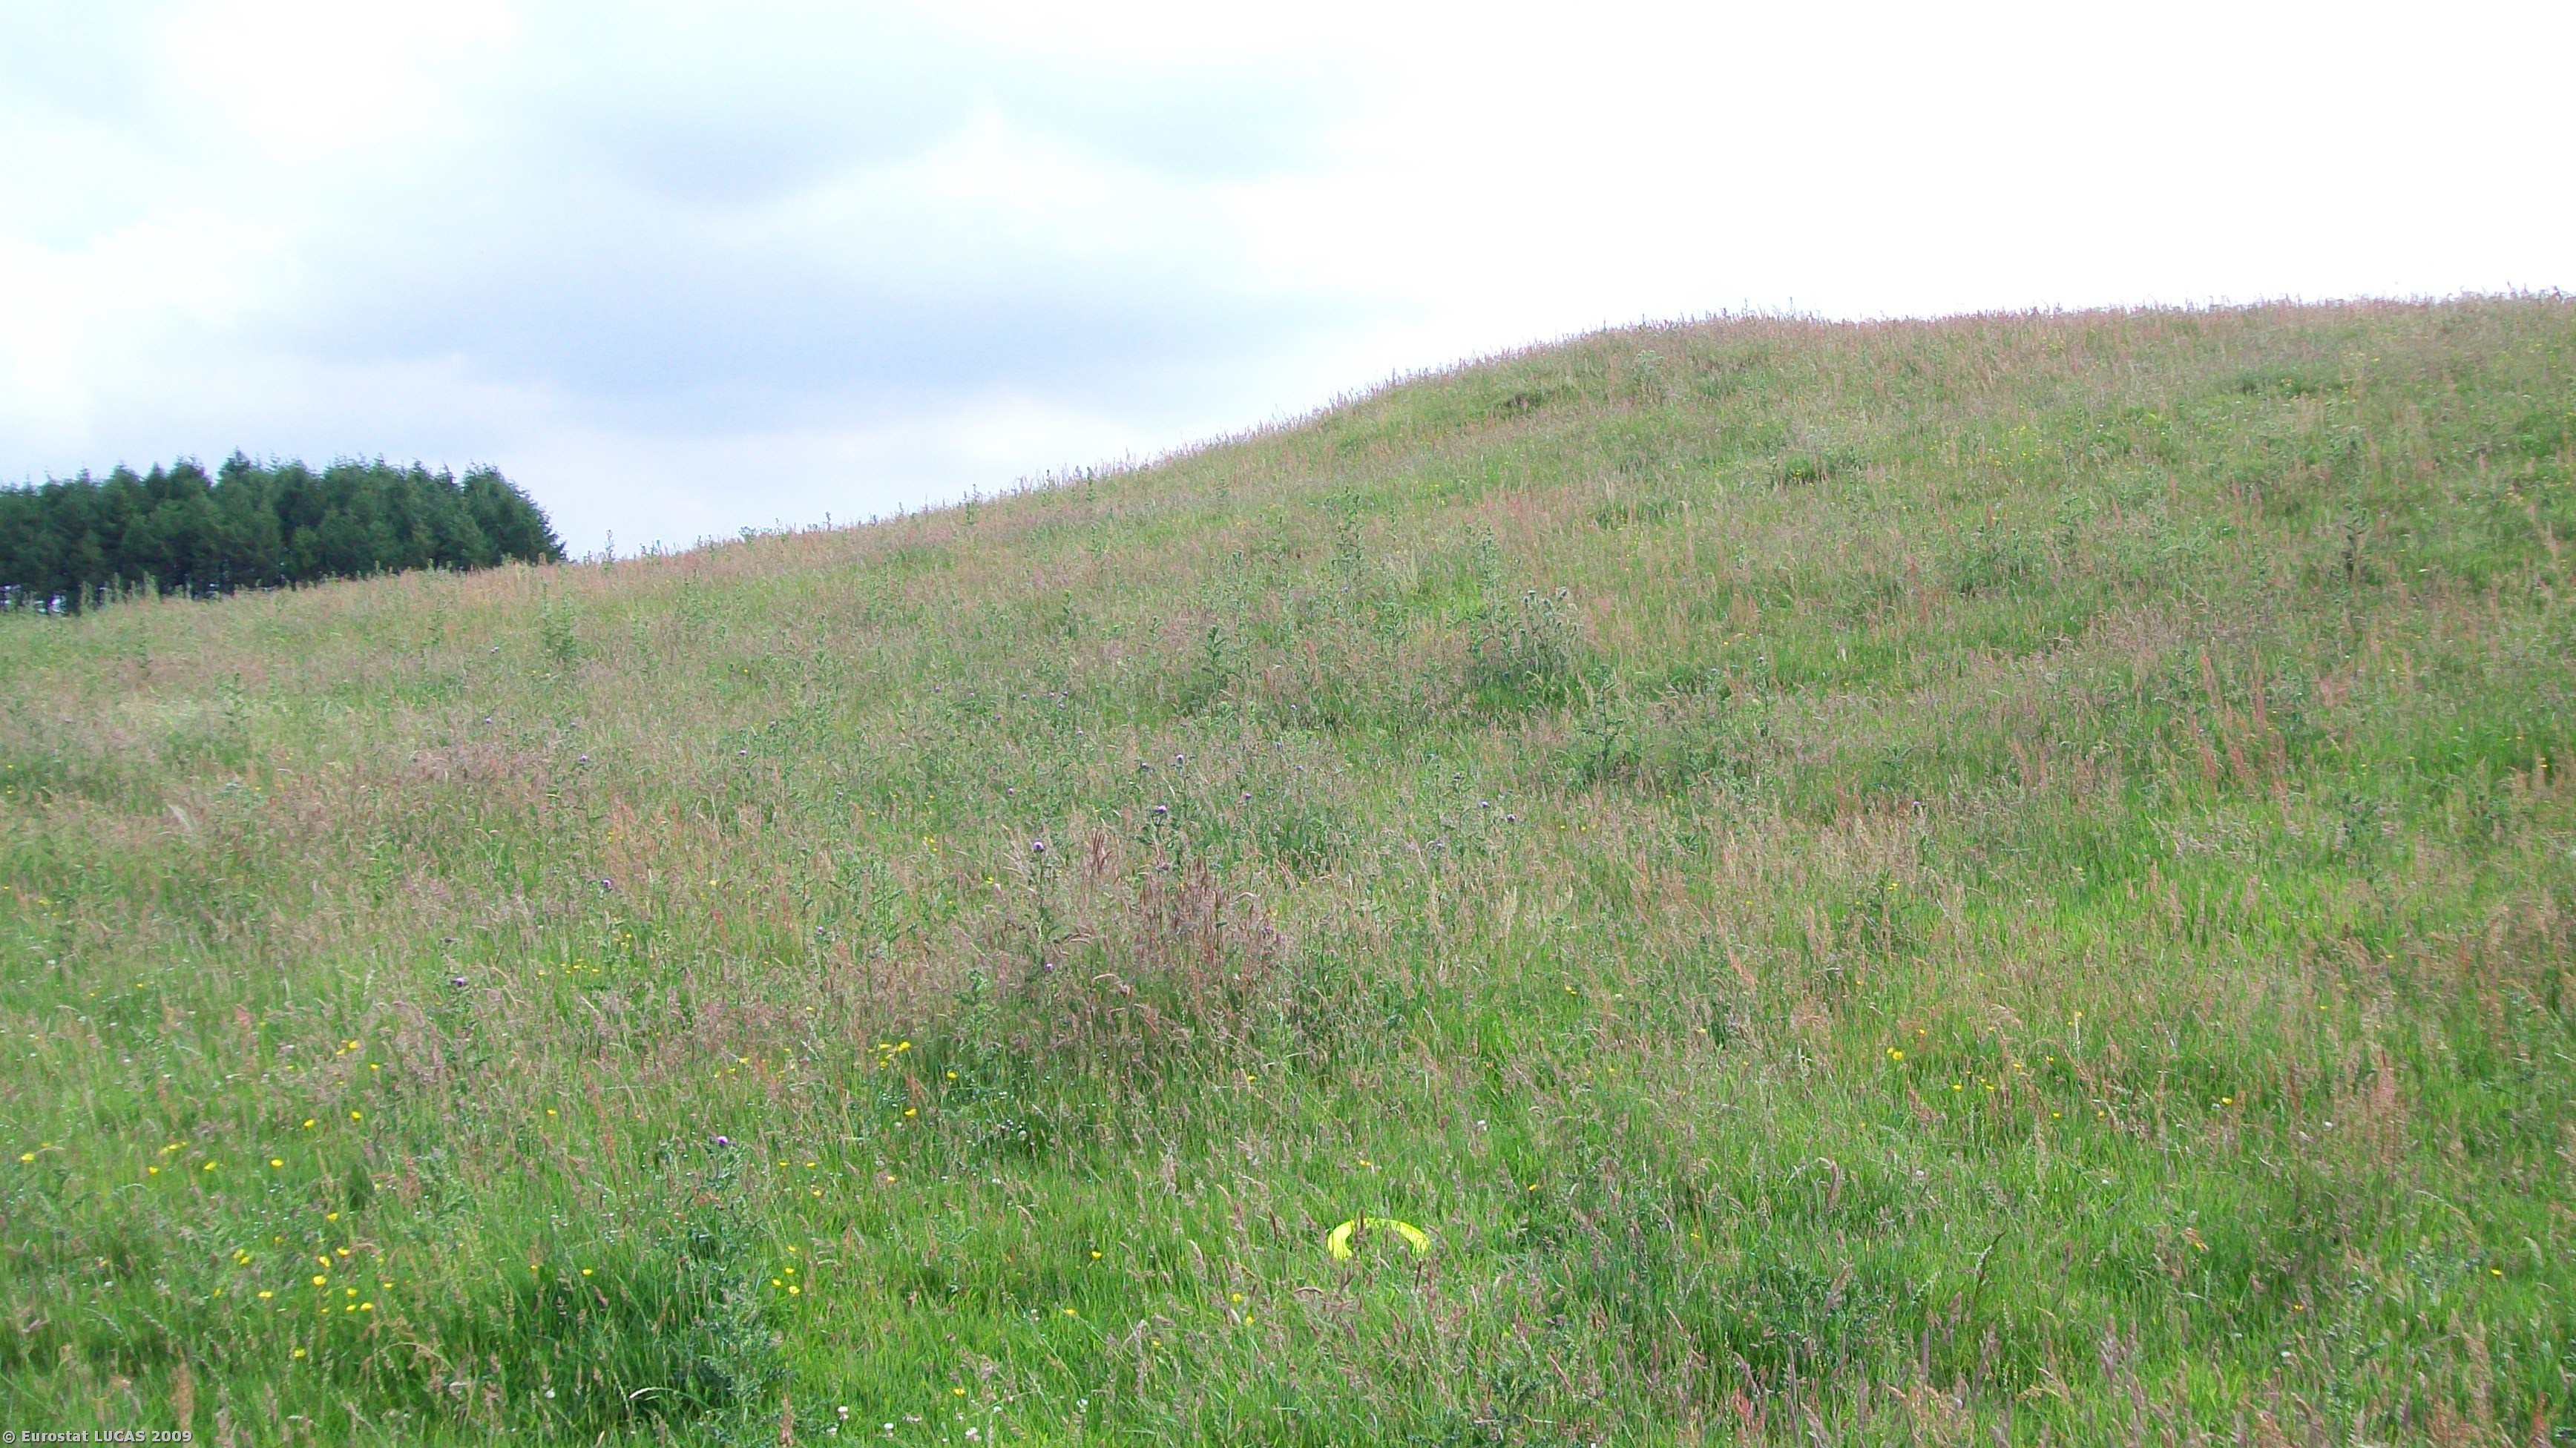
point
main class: Grassland
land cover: Grassland without tree/shrub cover
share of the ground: > 75 %
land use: Agriculture (excluding fallow land and kitchen gardens)
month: July
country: GB
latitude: 54.9856
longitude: -4.0790
